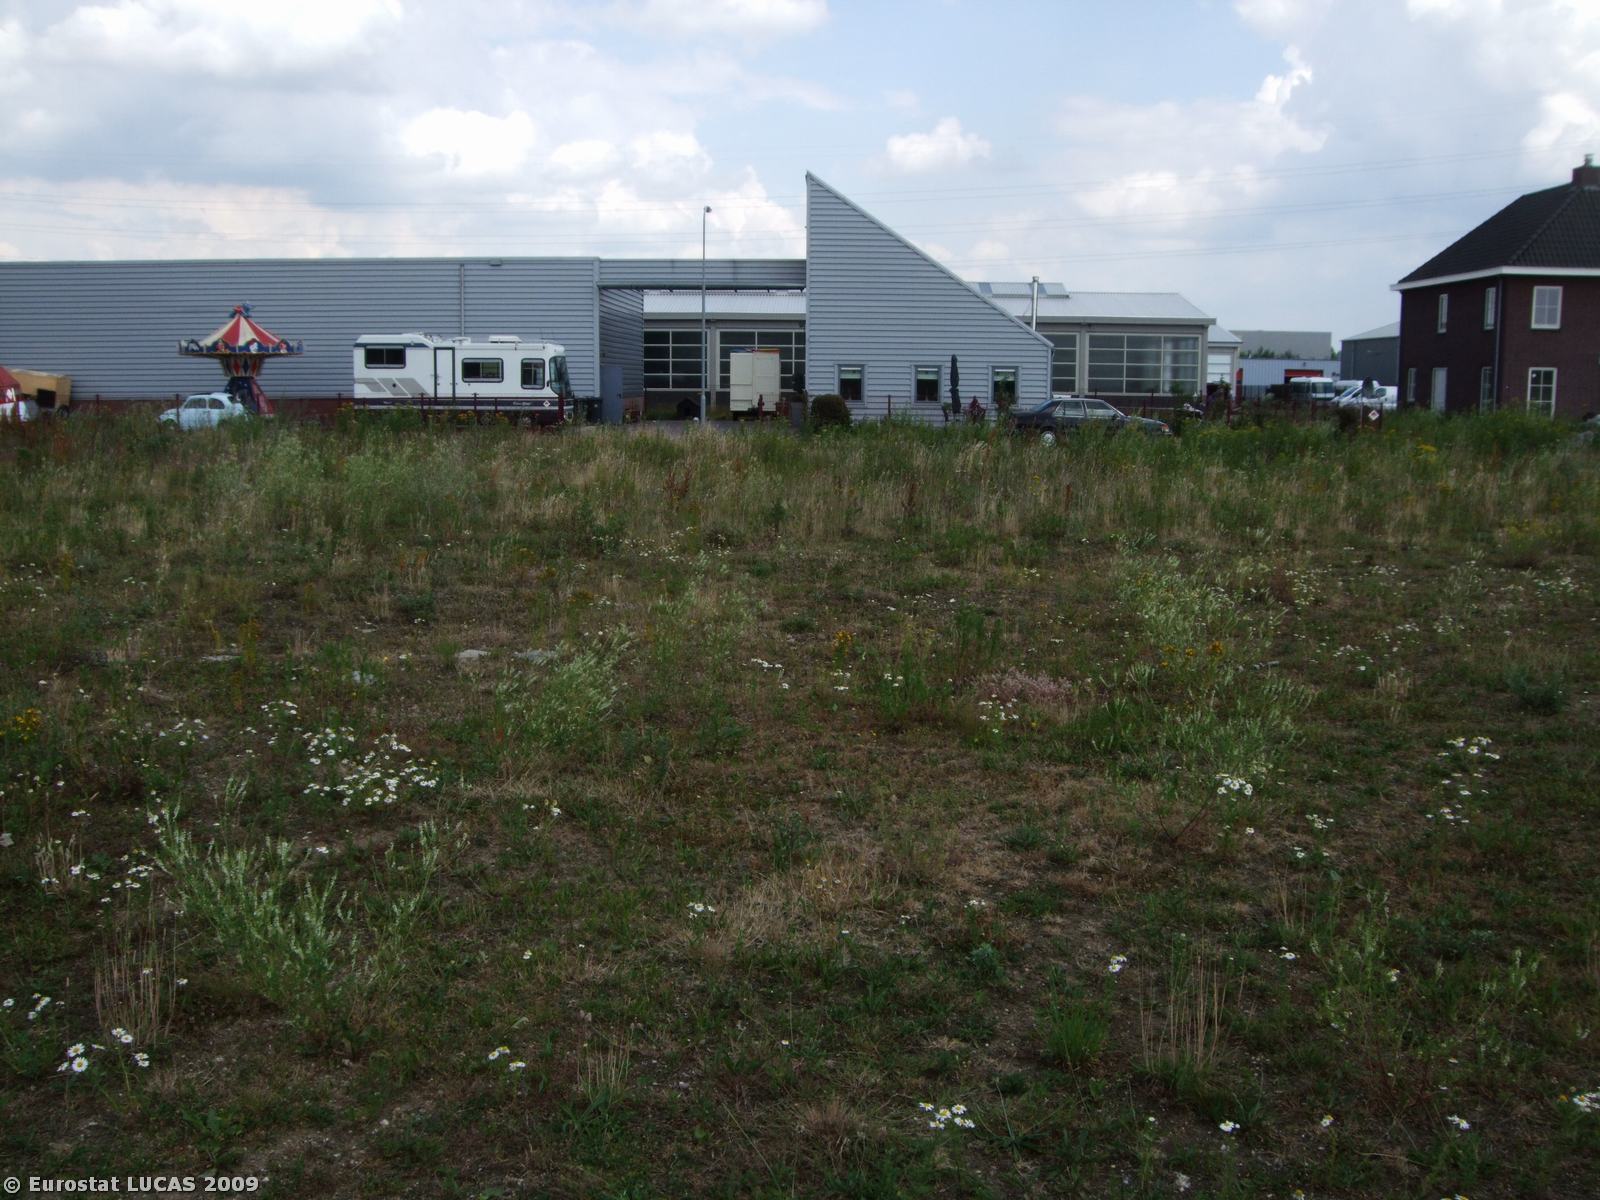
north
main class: Grassland
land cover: Spontaneously vegetated surfaces
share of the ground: 50 - 75 %
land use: Unused
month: July
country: NL
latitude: 51.8942
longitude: 5.4498
